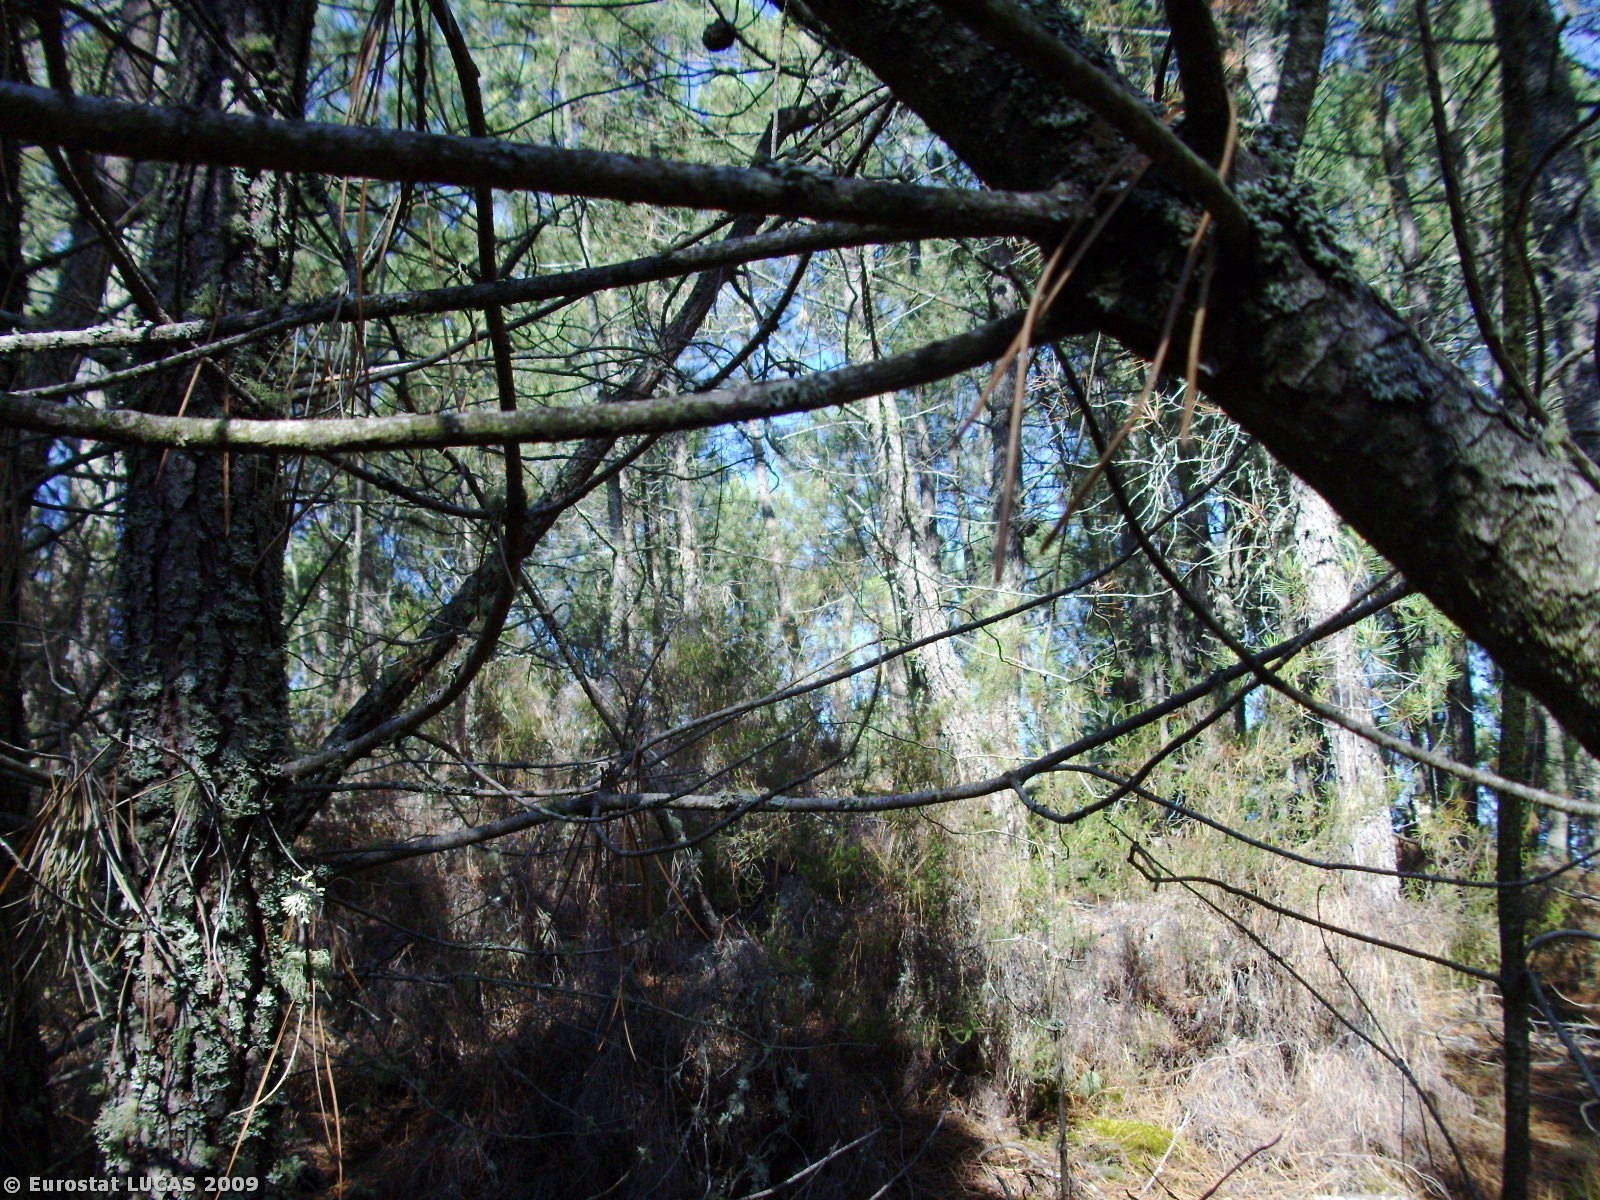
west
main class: Woodland
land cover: Coniferous woodland
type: coniferous forest of the mediterranean region
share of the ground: > 75 %
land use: Forestry
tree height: > 5 m
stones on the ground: 10 - 25 %
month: July
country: PT
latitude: 41.0141
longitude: -7.7607
